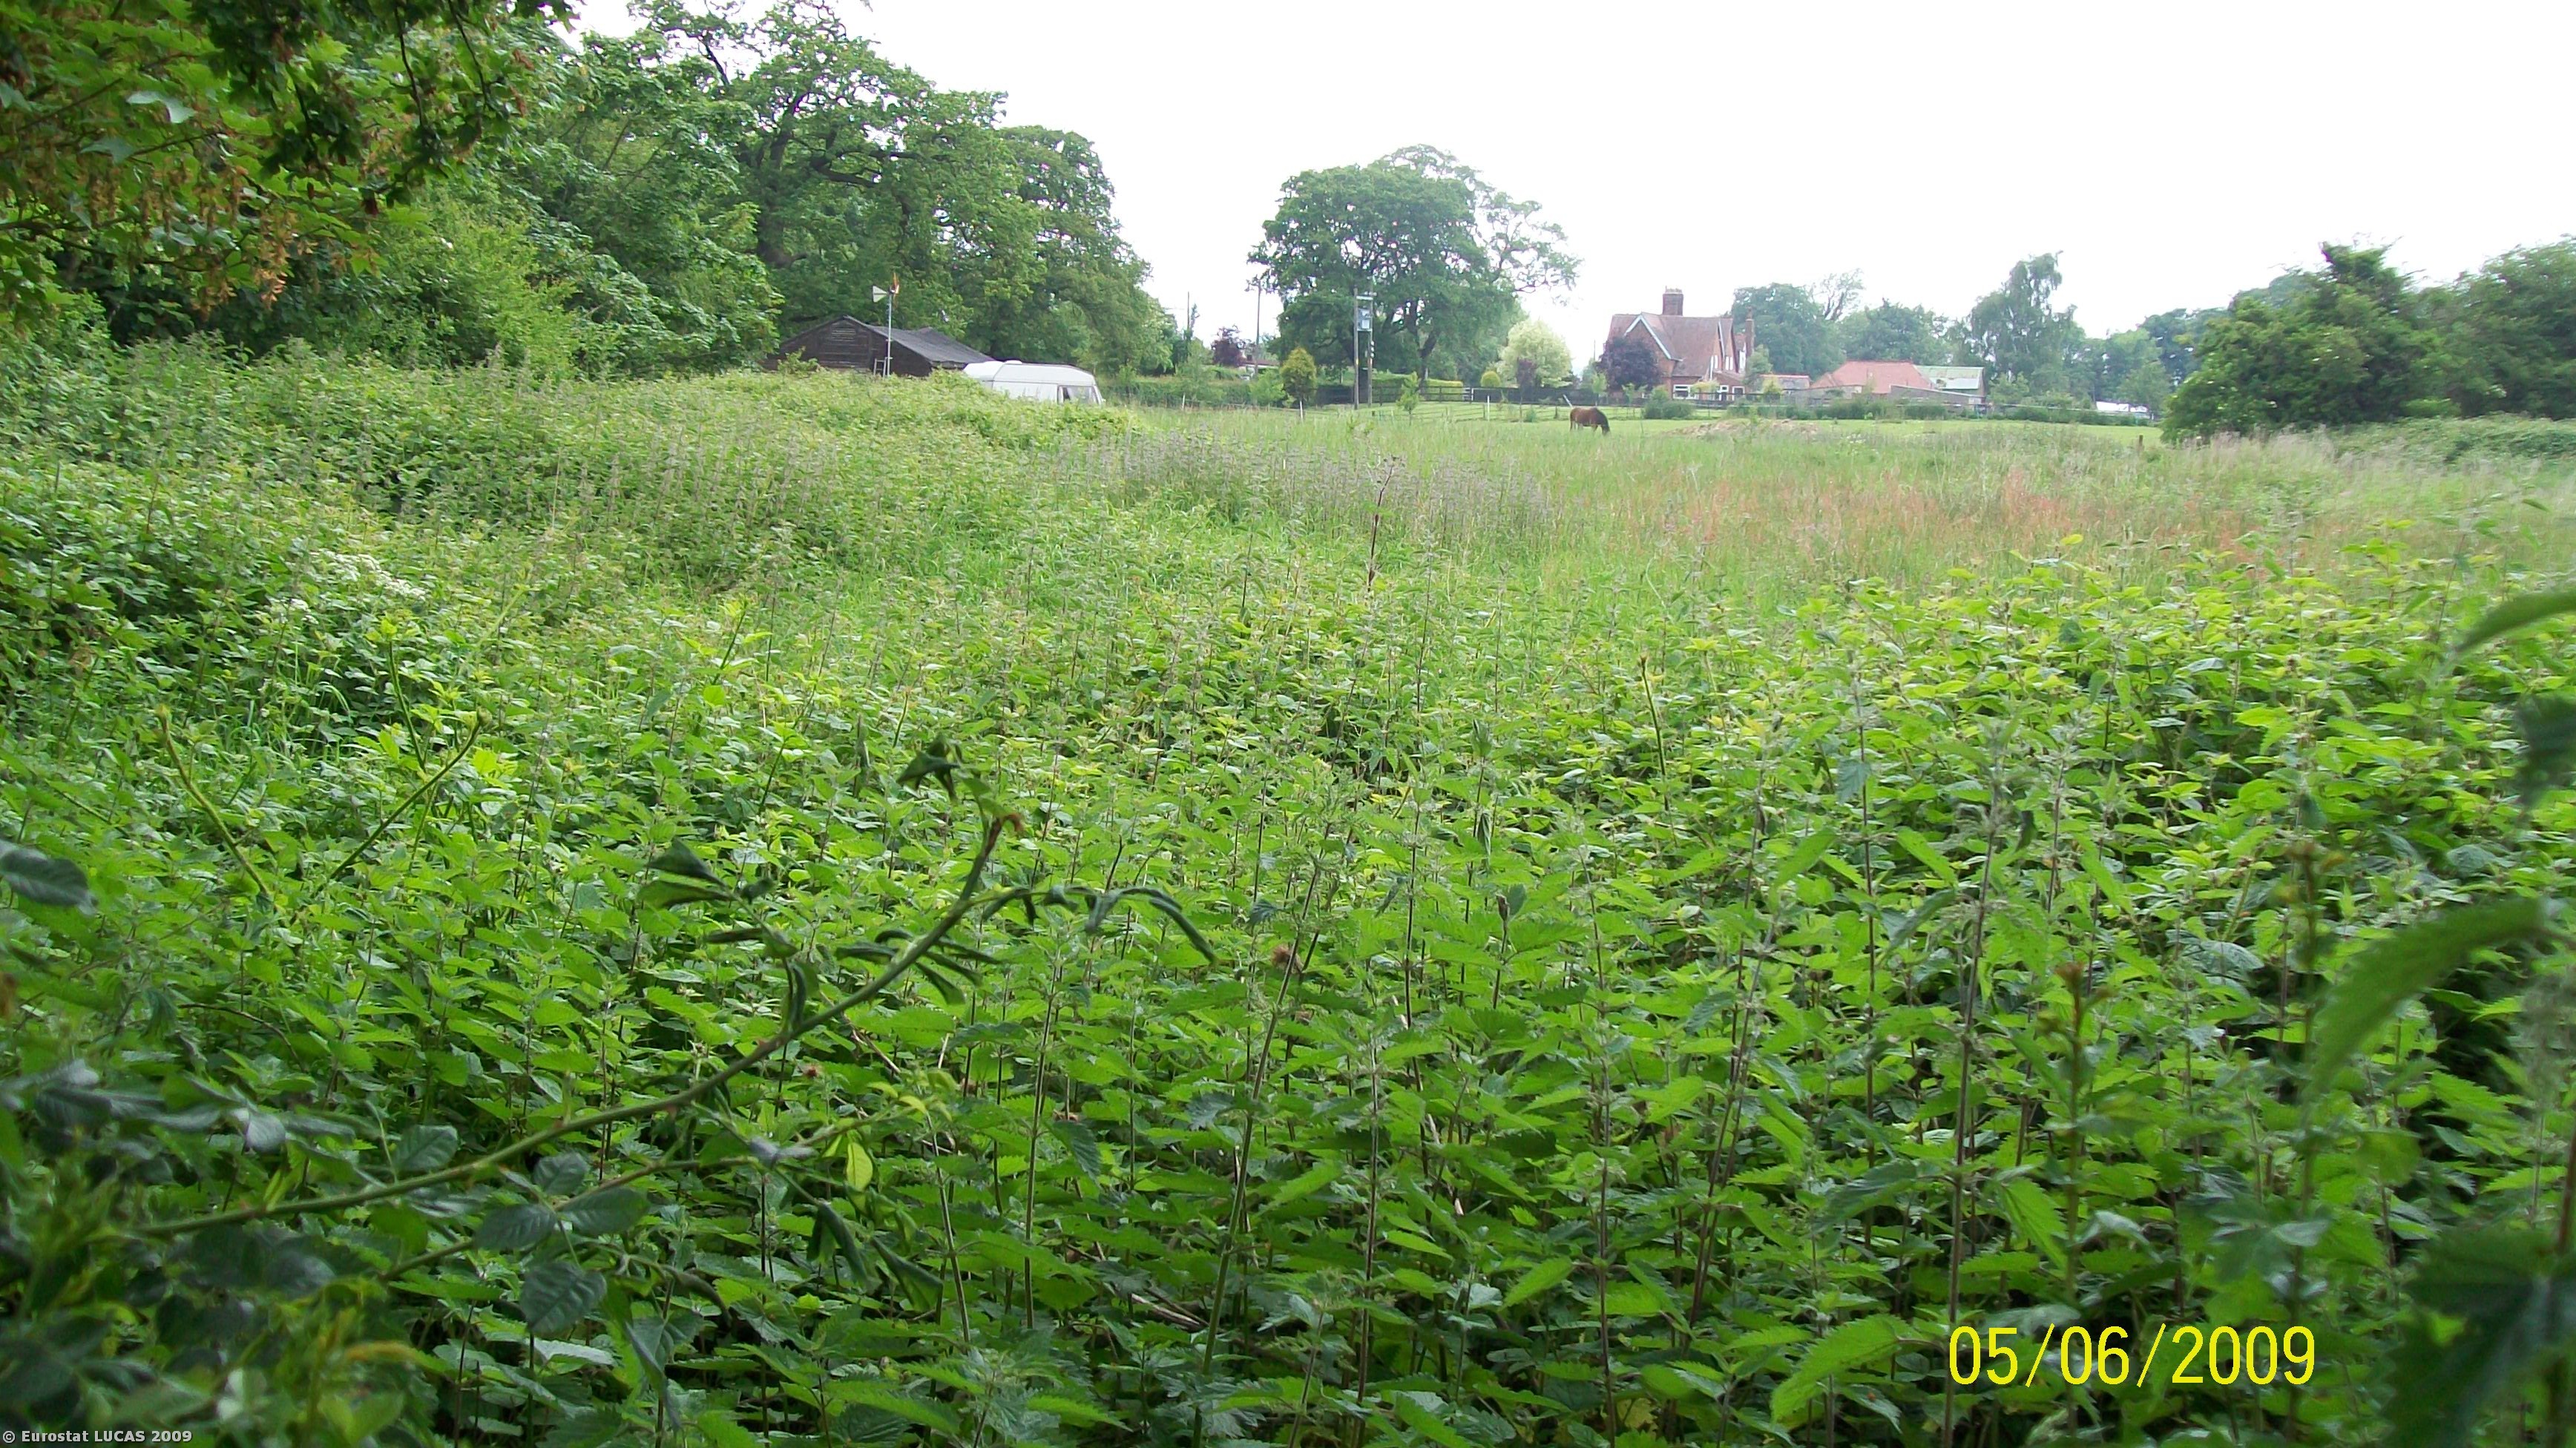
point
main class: Grassland
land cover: Grassland without tree/shrub cover
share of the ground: > 75 %
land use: Fallow land
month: June
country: GB
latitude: 53.0984
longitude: -2.6584
